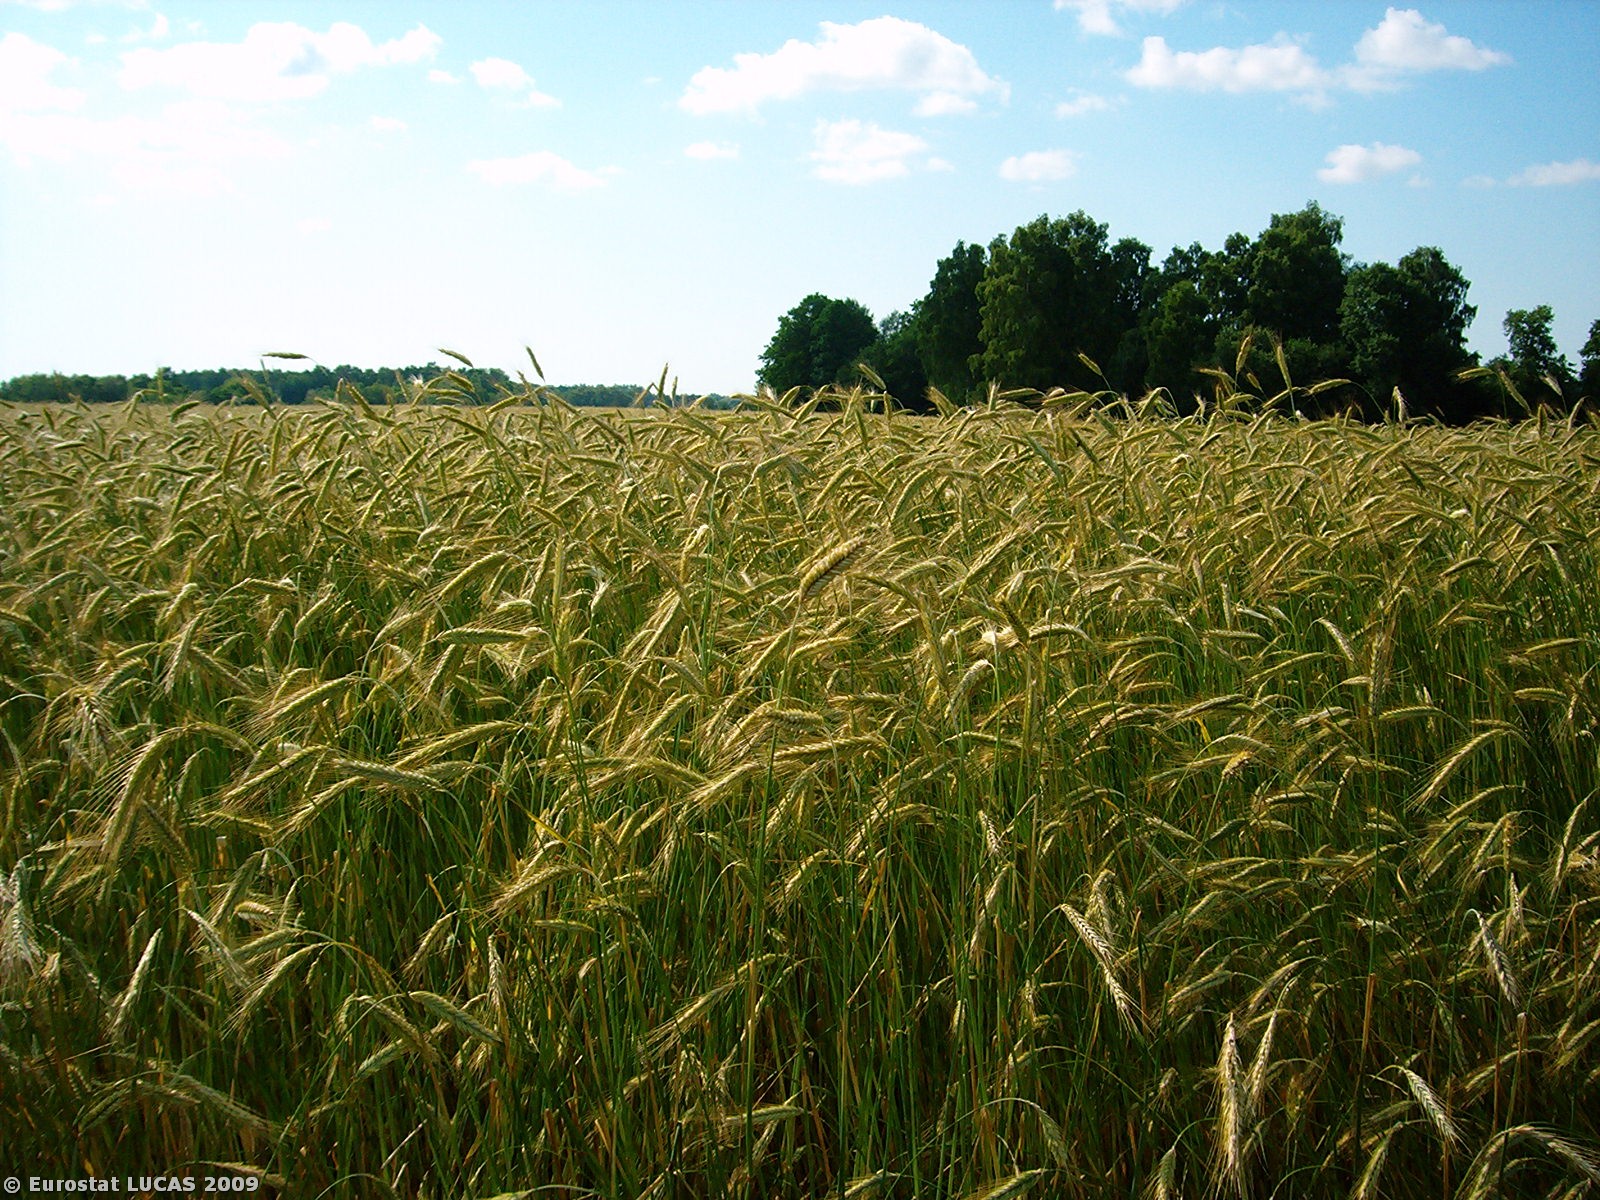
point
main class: Cropland
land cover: Triticale
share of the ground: > 75 %
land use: Agriculture (excluding fallow land and kitchen gardens)
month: July
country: PL
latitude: 53.6032
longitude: 15.4586
